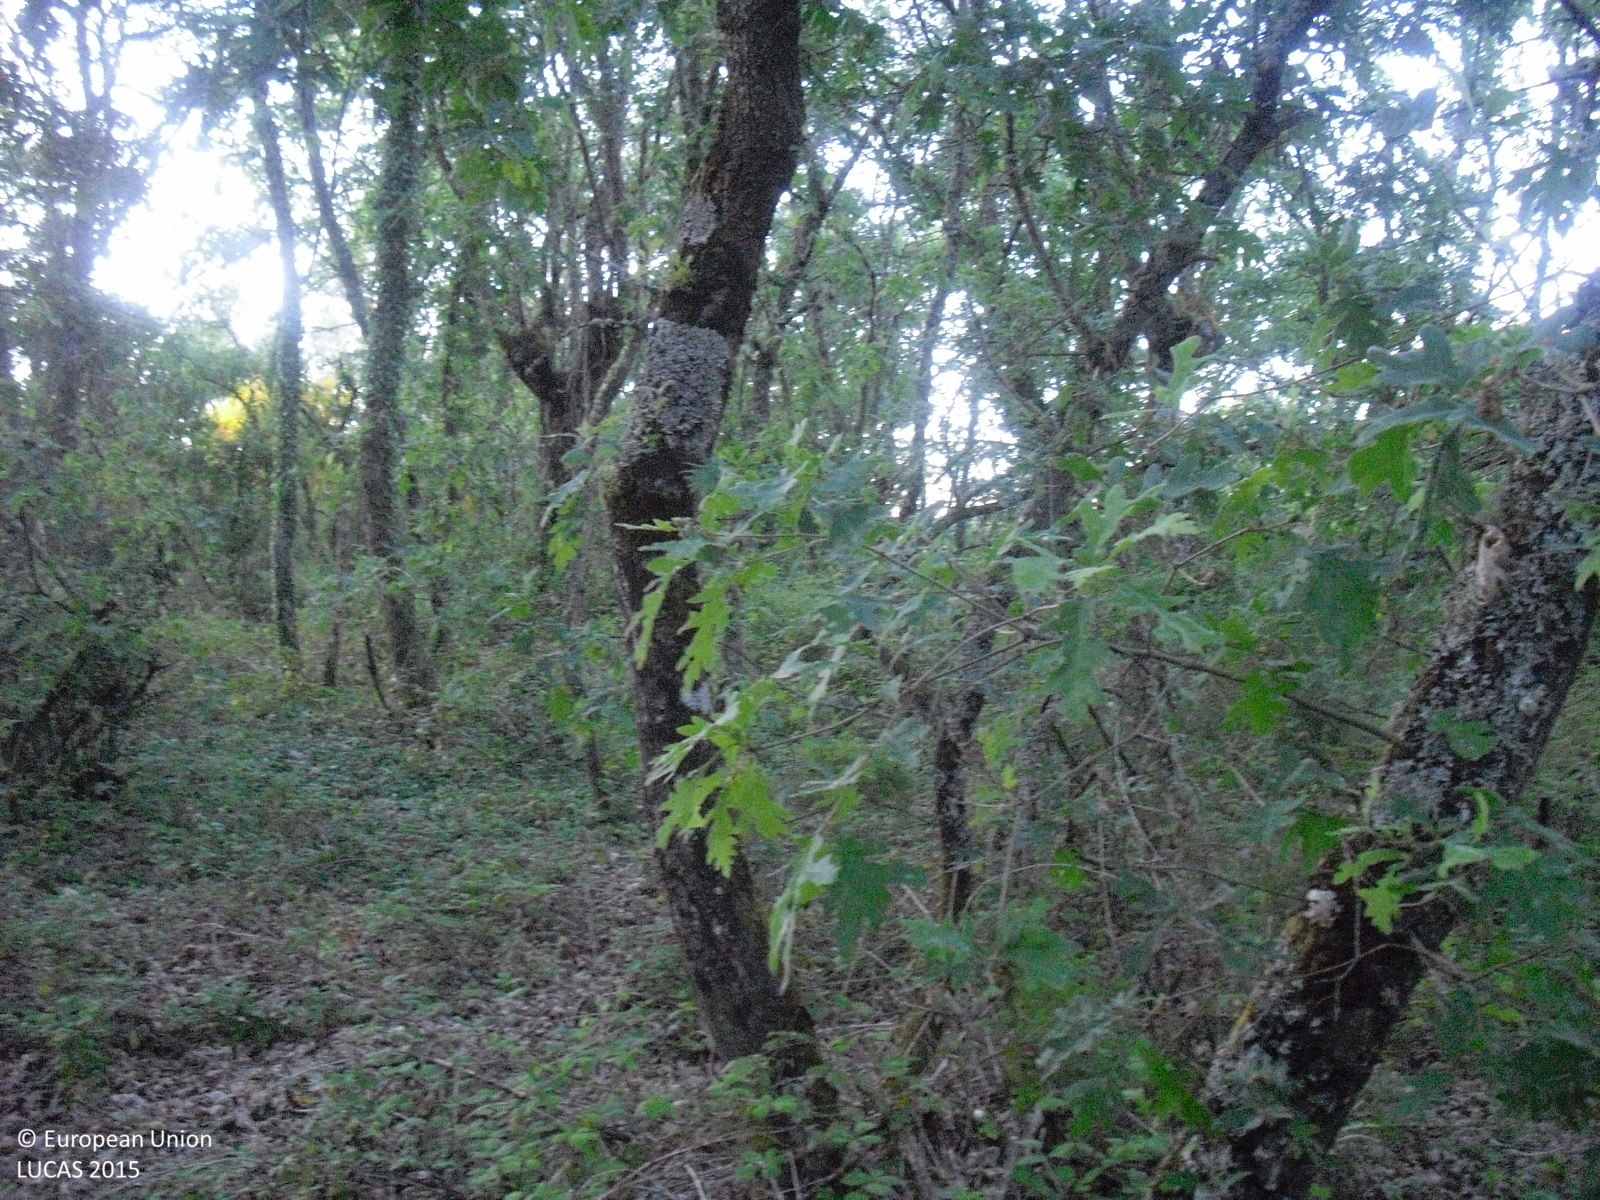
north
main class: Woodland
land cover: Broadleaved woodland
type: acidophilous oak and oak-birch forest
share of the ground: > 75 %
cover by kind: broadleaved forest trees 100 %
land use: Forestry
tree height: > 5 m
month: May
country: ES
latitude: 42.2157
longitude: -7.7461
